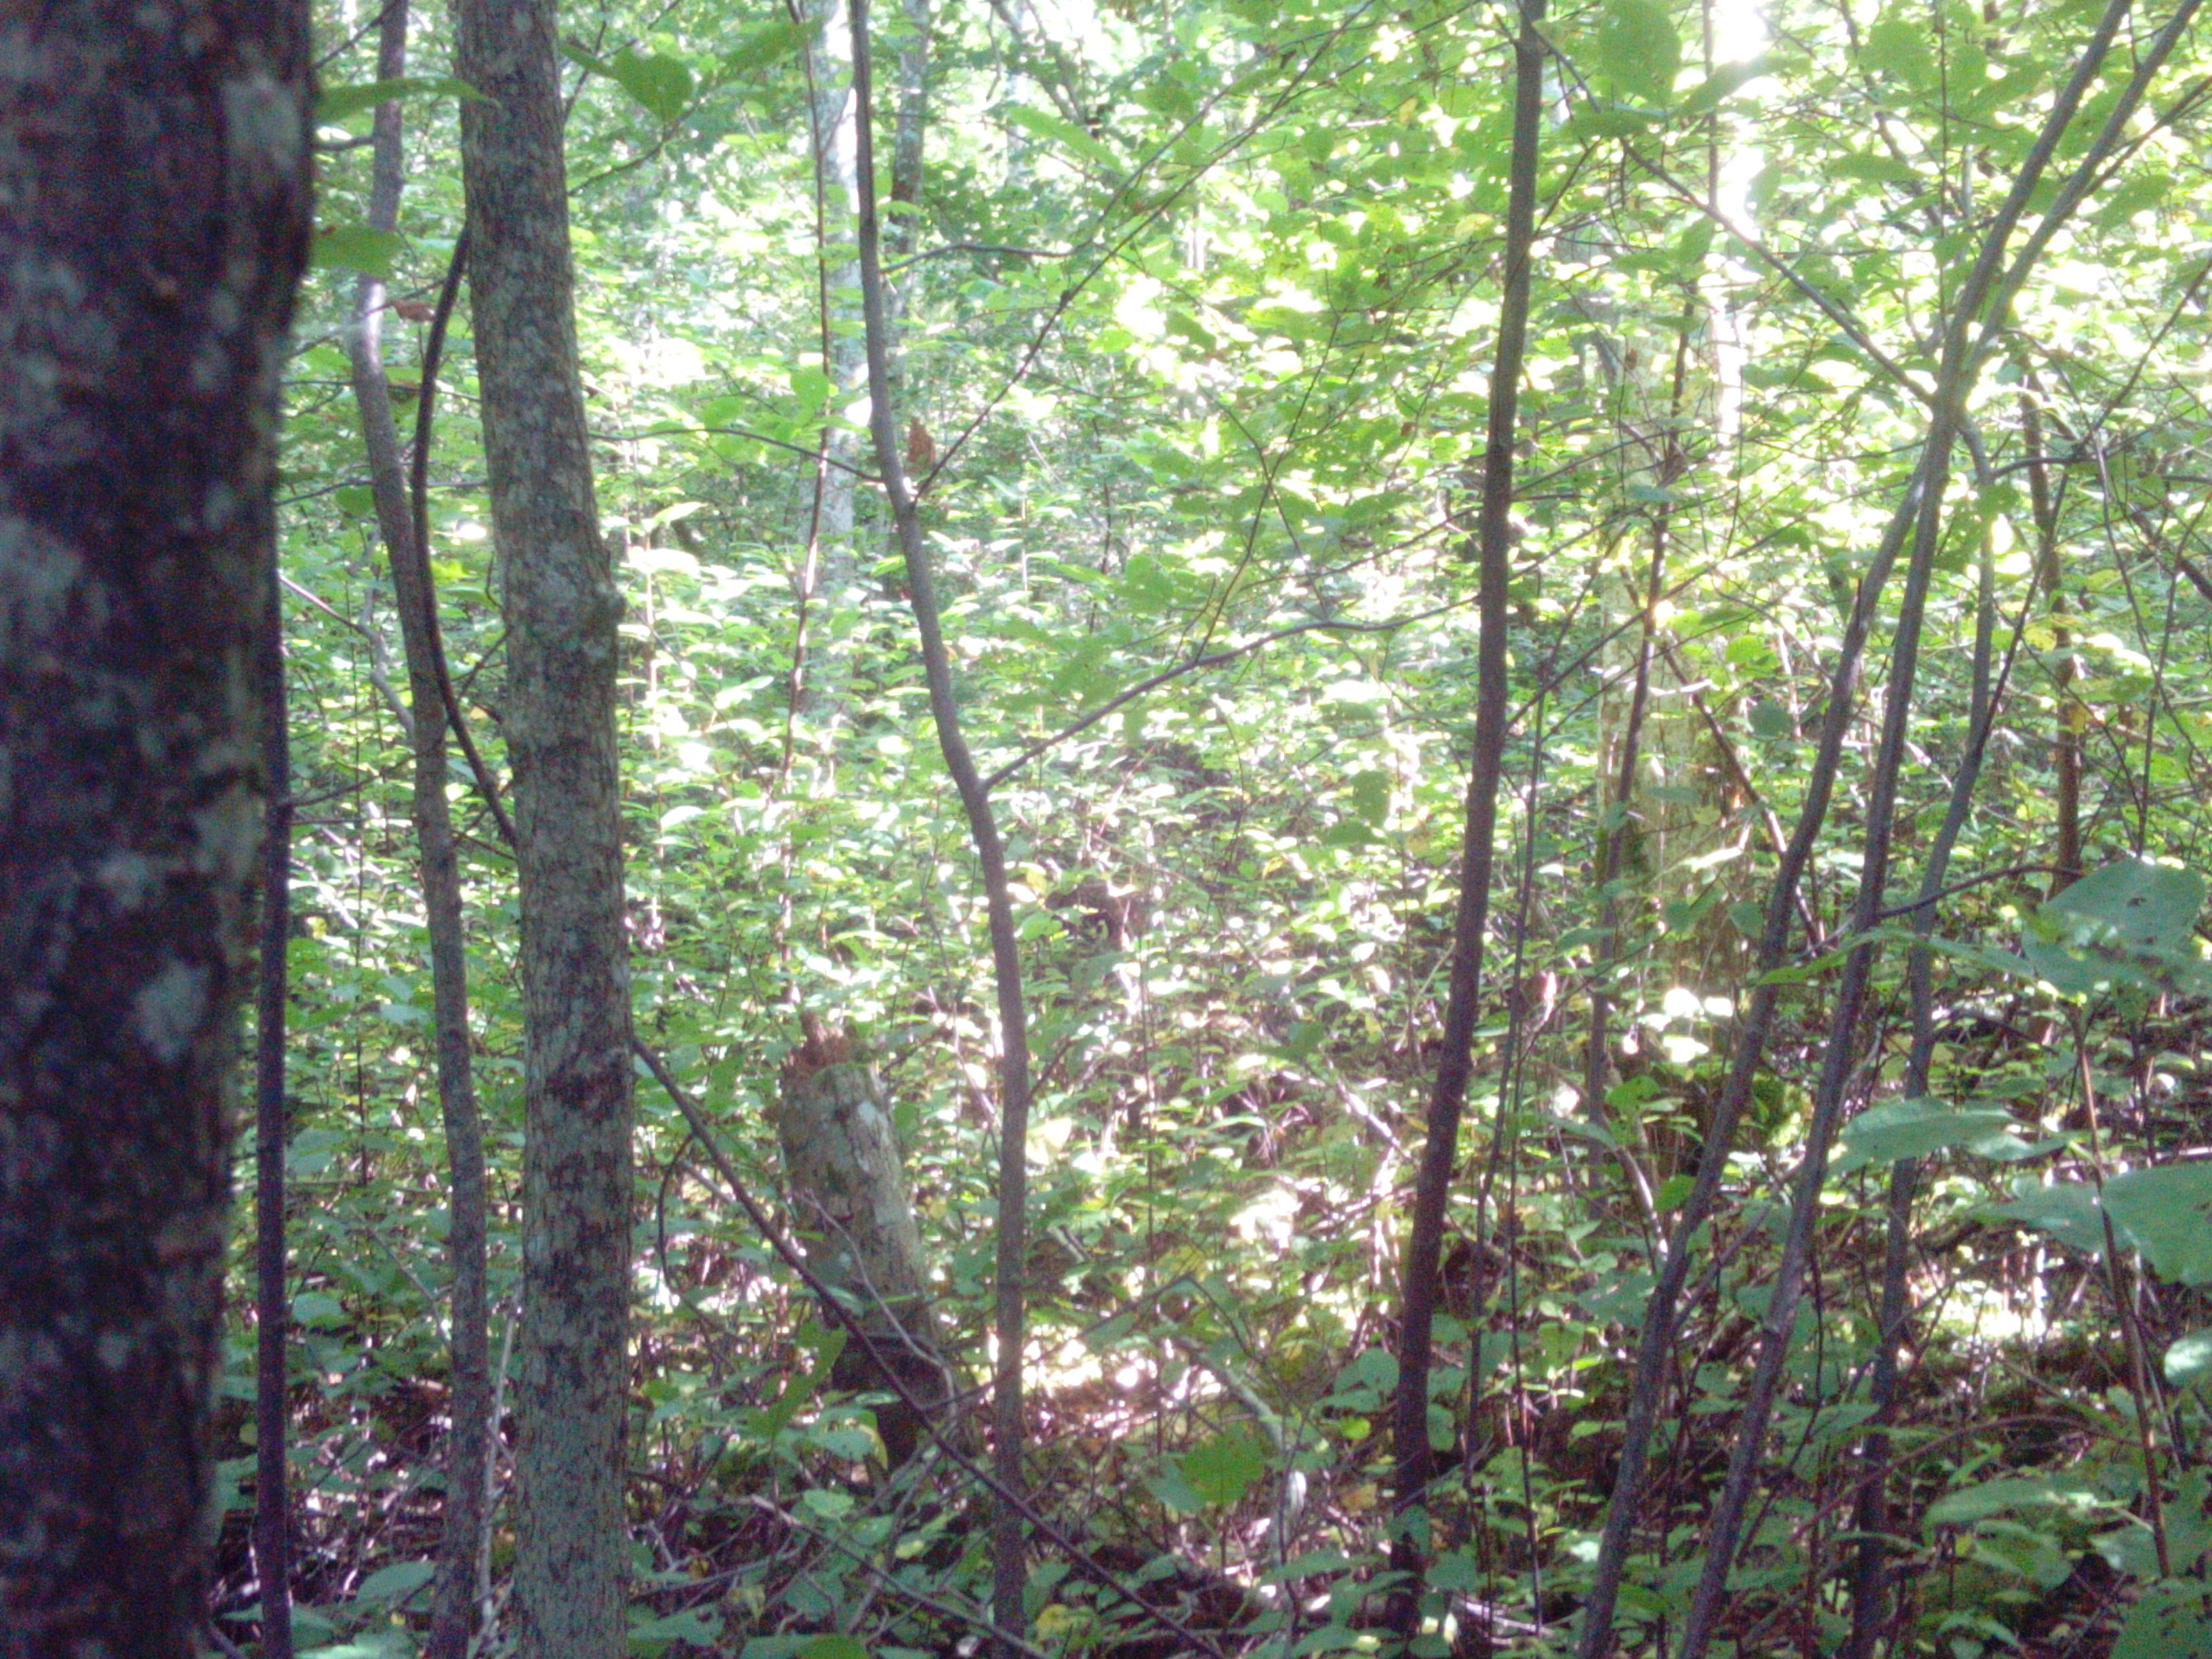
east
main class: Woodland
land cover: Broadleaved woodland
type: non-riverine alder, birch or aspen forest
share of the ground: > 75 %
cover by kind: broadleaved forest trees 95 %, herbaceous plants 5 %
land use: Forestry
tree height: > 5 m
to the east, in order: Broadleaved woodland; Ditches and canals; Broadleaved woodland; Ditches and canals; Grass margins; Paved roads, cycling and walking lanes; Ditches and canals; Abandoned hedges; Fences; Spontaneously vegetated surfaces; Fences; Spontaneously vegetated surfaces; Broadleaved woodland
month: August
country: LV
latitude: 56.4992
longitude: 21.3632
